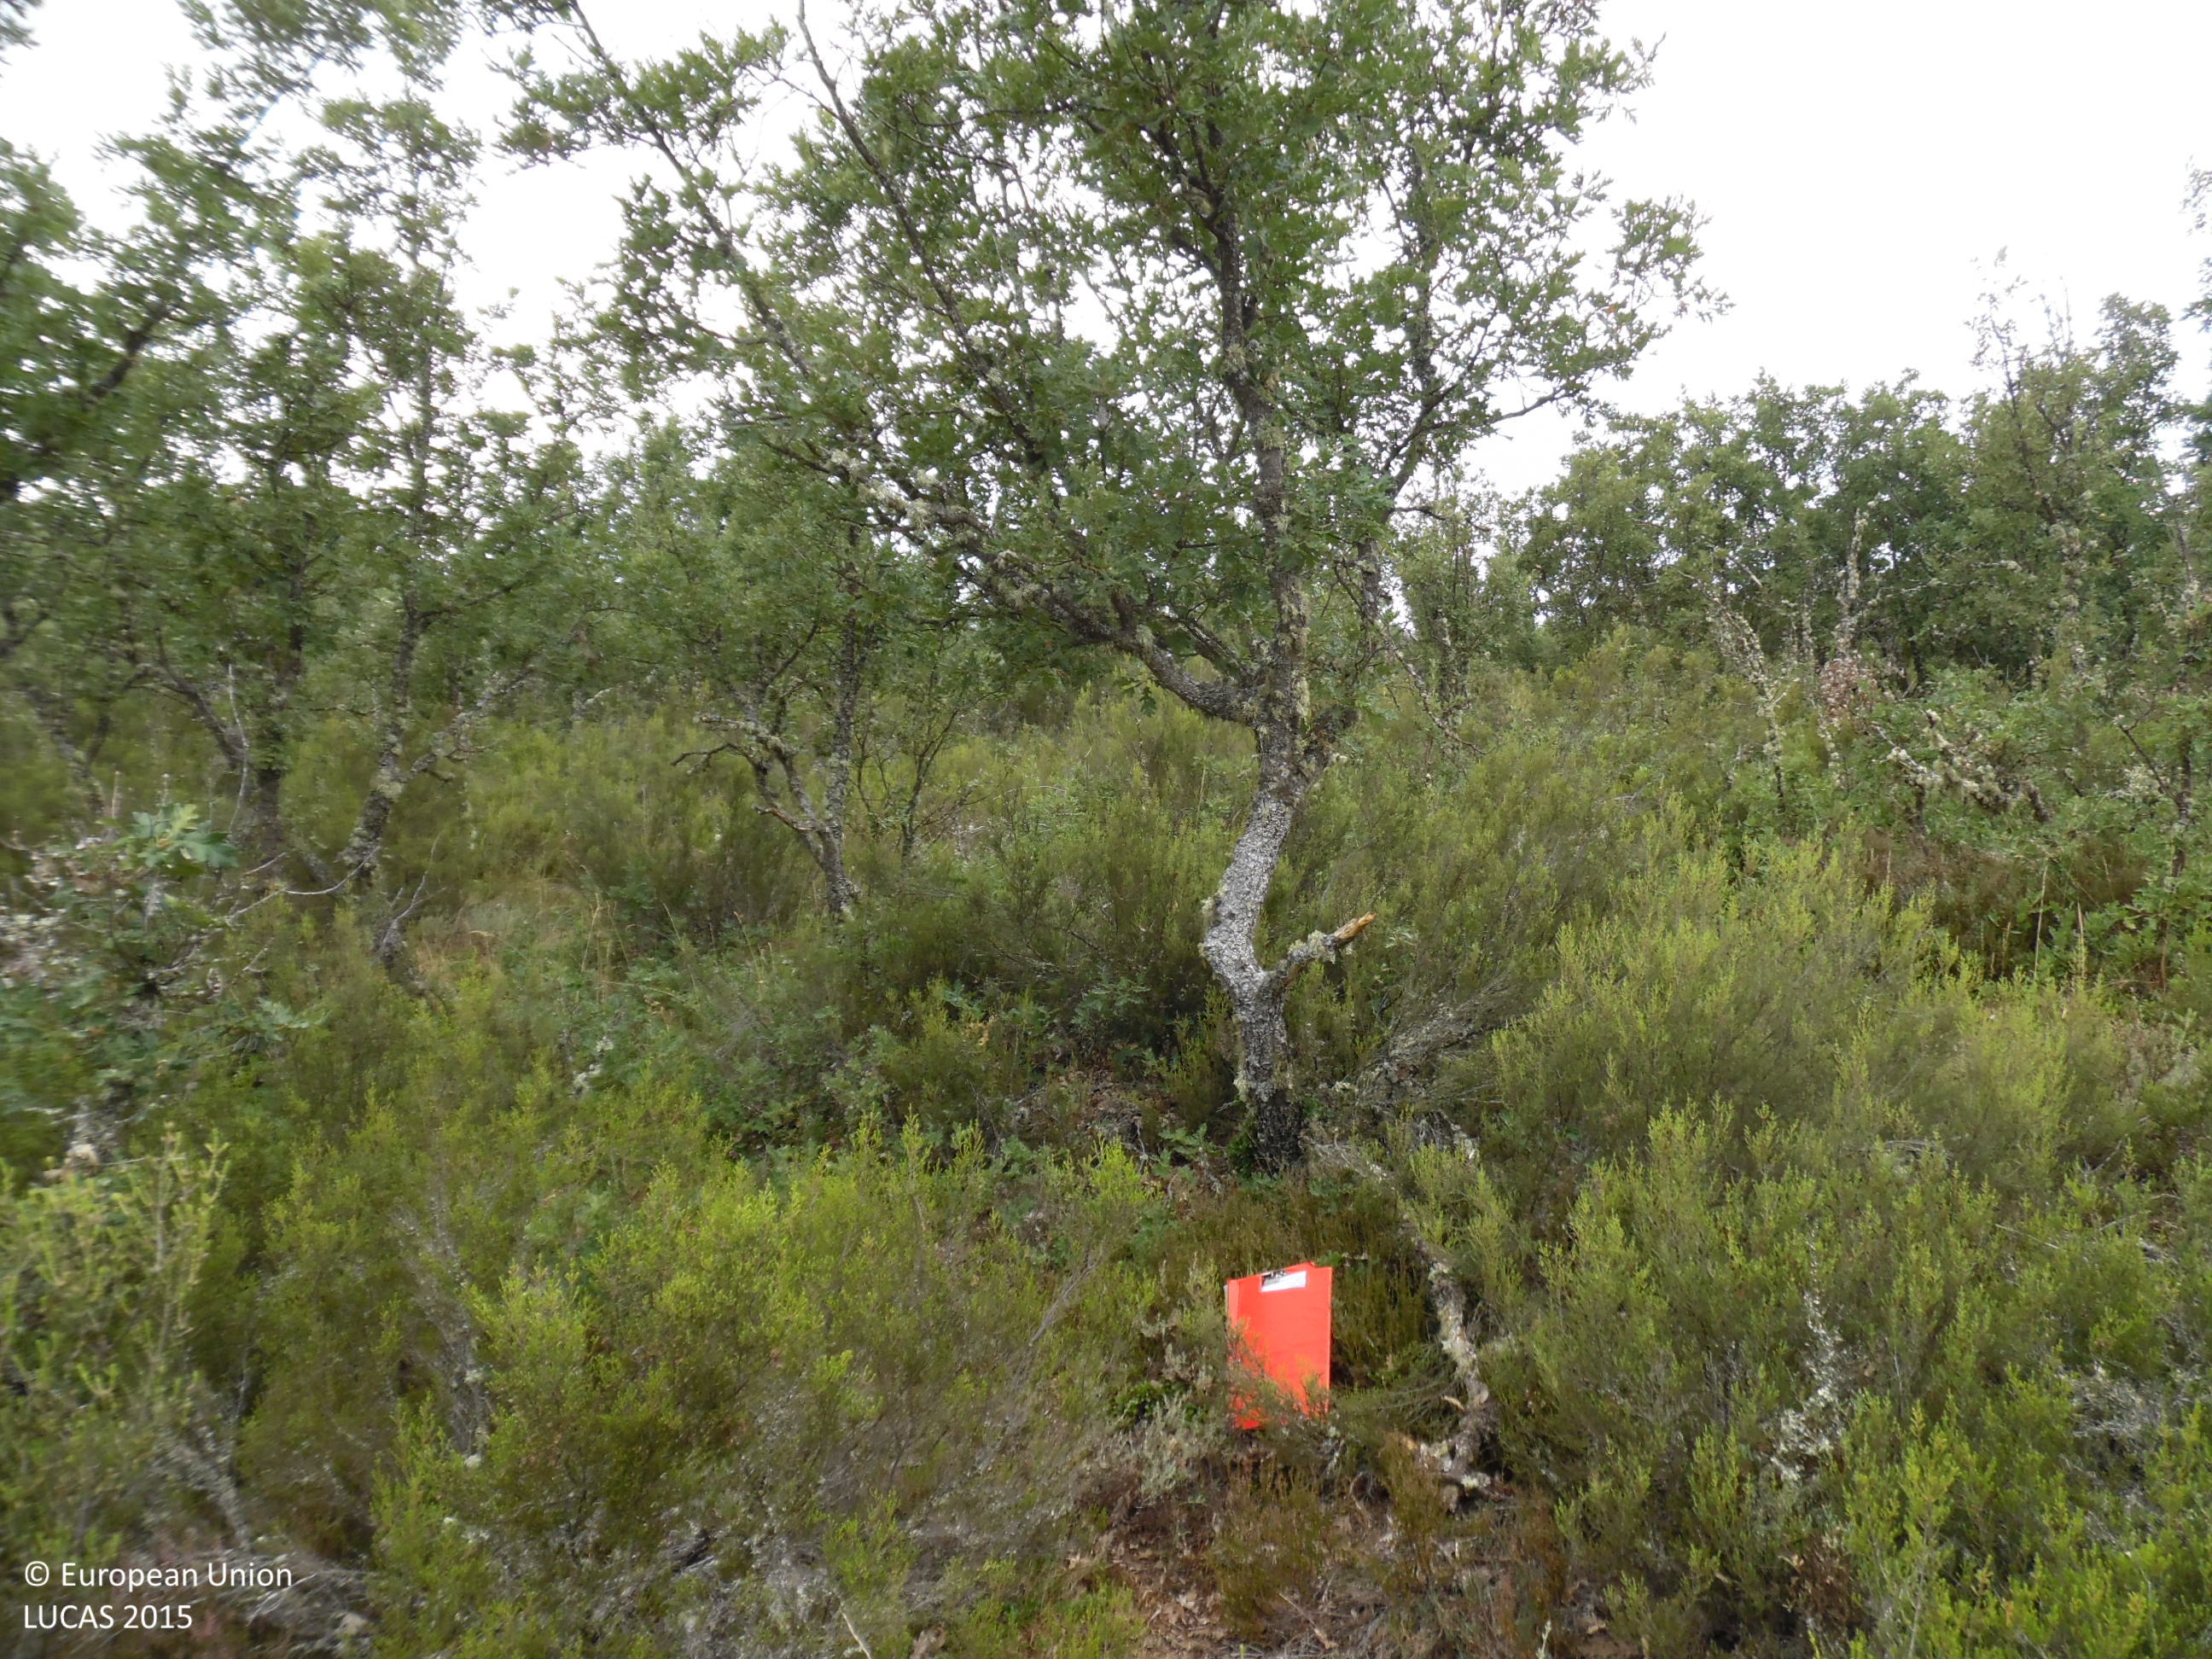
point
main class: Woodland
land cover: Broadleaved woodland
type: broadleaved evergreen forest
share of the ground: > 75 %
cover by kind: broadleaved forest trees 90 %, shrubs 10 %
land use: Forestry
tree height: > 5 m
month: July
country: ES
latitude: 42.6256
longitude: -5.7447
